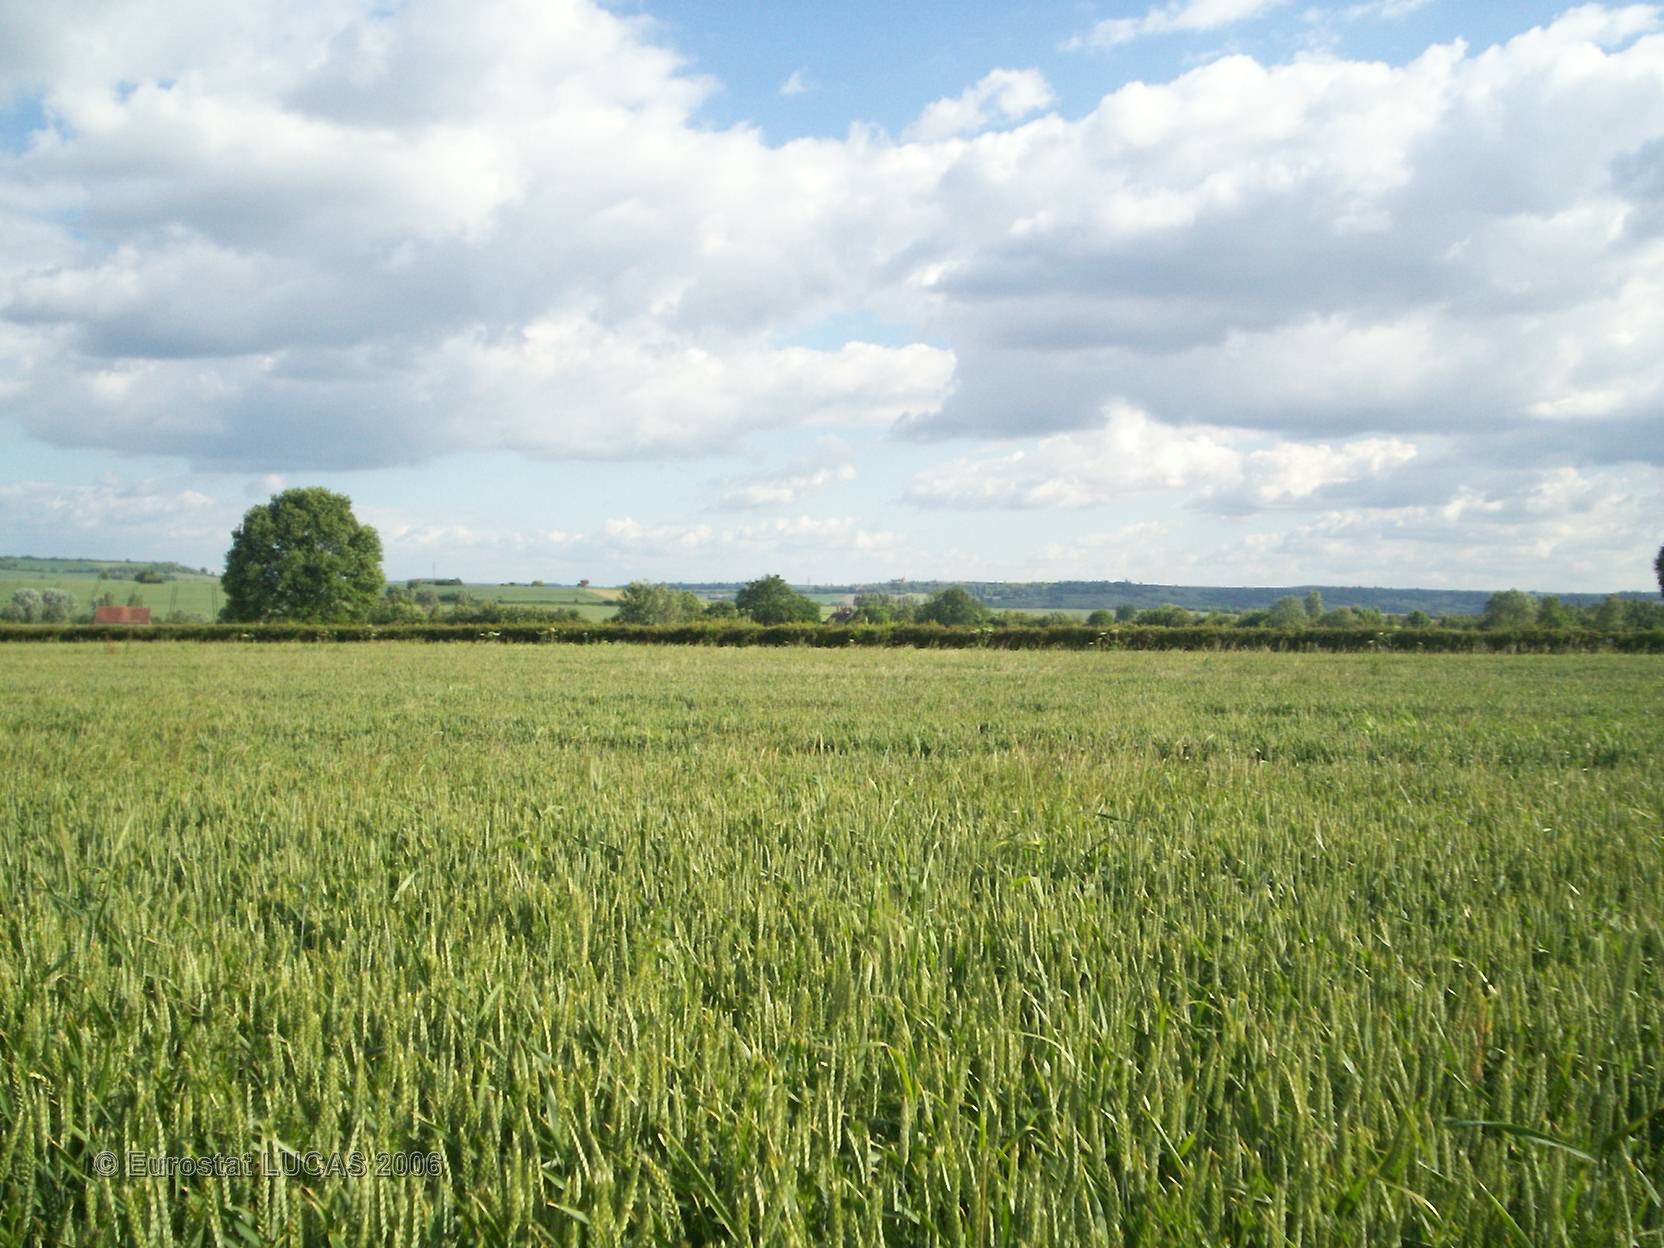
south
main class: Cropland
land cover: Common wheat
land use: Agriculture (excluding fallow land and kitchen gardens)
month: June
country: FR
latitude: 46.2196
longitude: 3.1146
